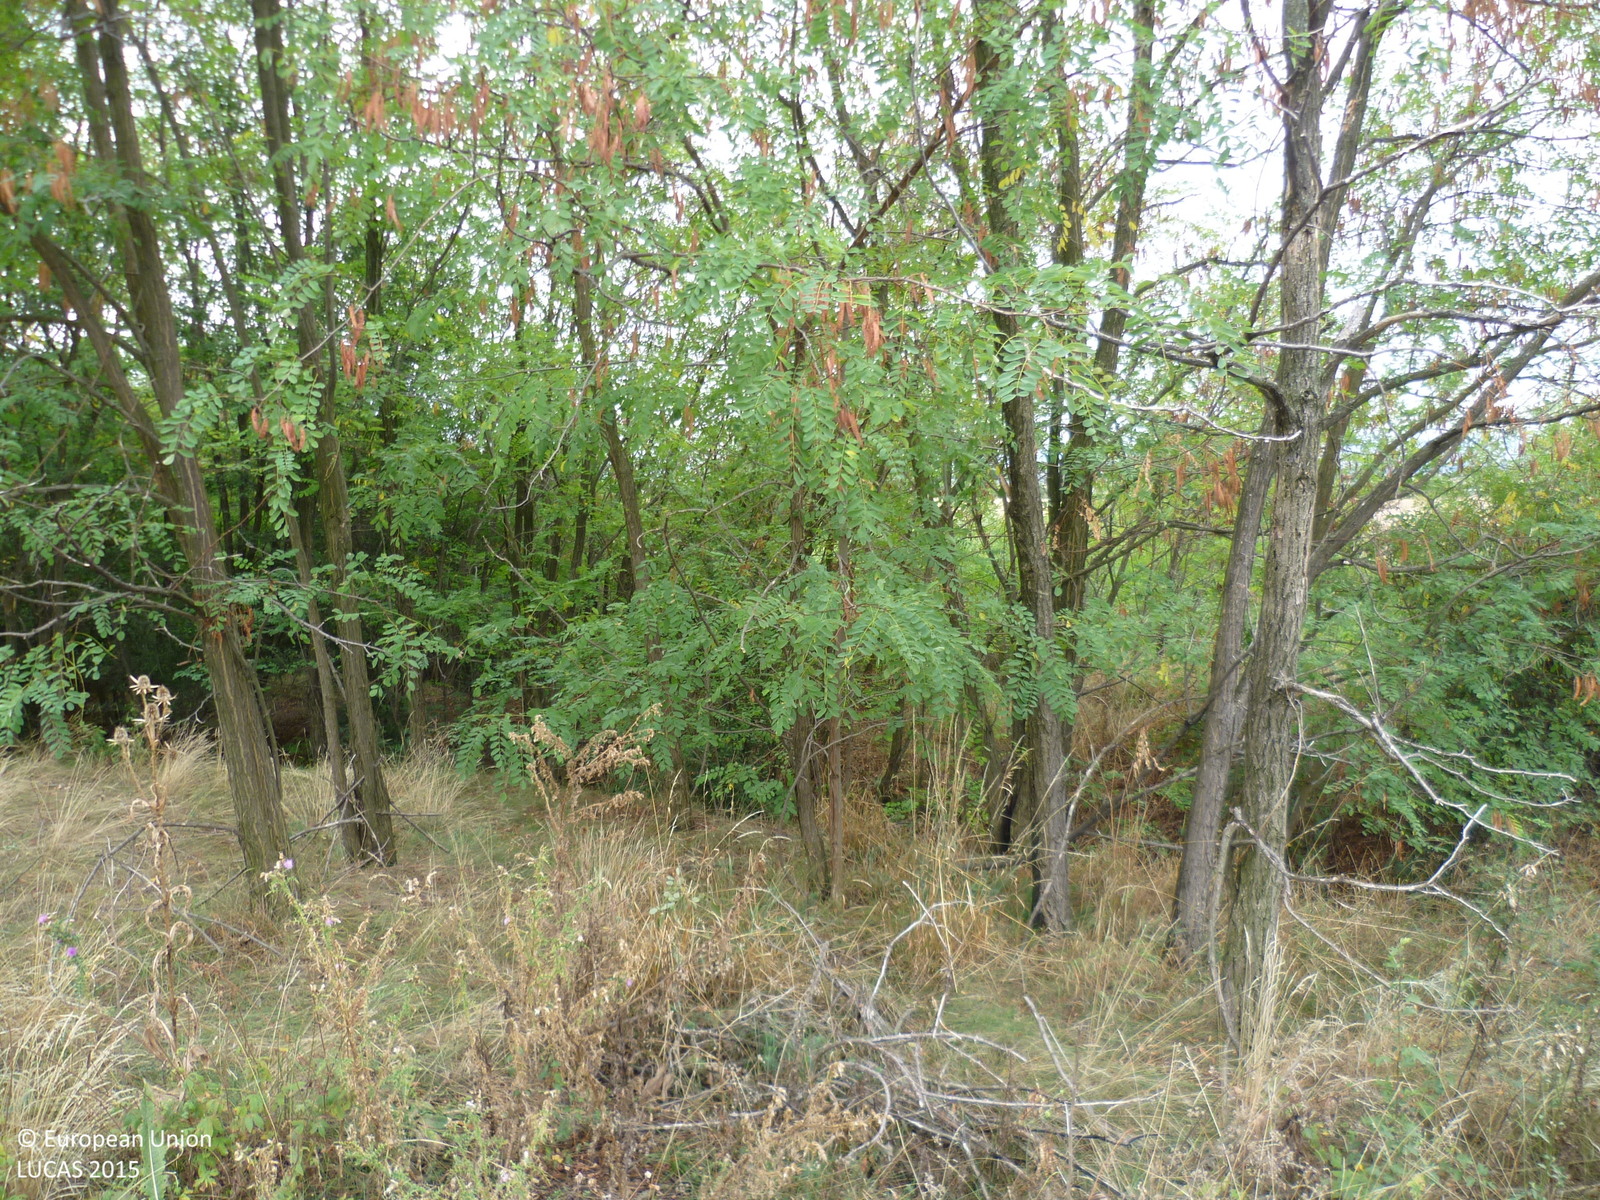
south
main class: Grassland
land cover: Grassland with sparse tree/shrub cover
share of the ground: > 75 %
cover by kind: herbaceous plants 85 %, shrubs 10 %, broadleaved forest trees 5 %
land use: Fallow land
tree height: > 5 m
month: September
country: BG
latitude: 42.8472
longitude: 23.1880
